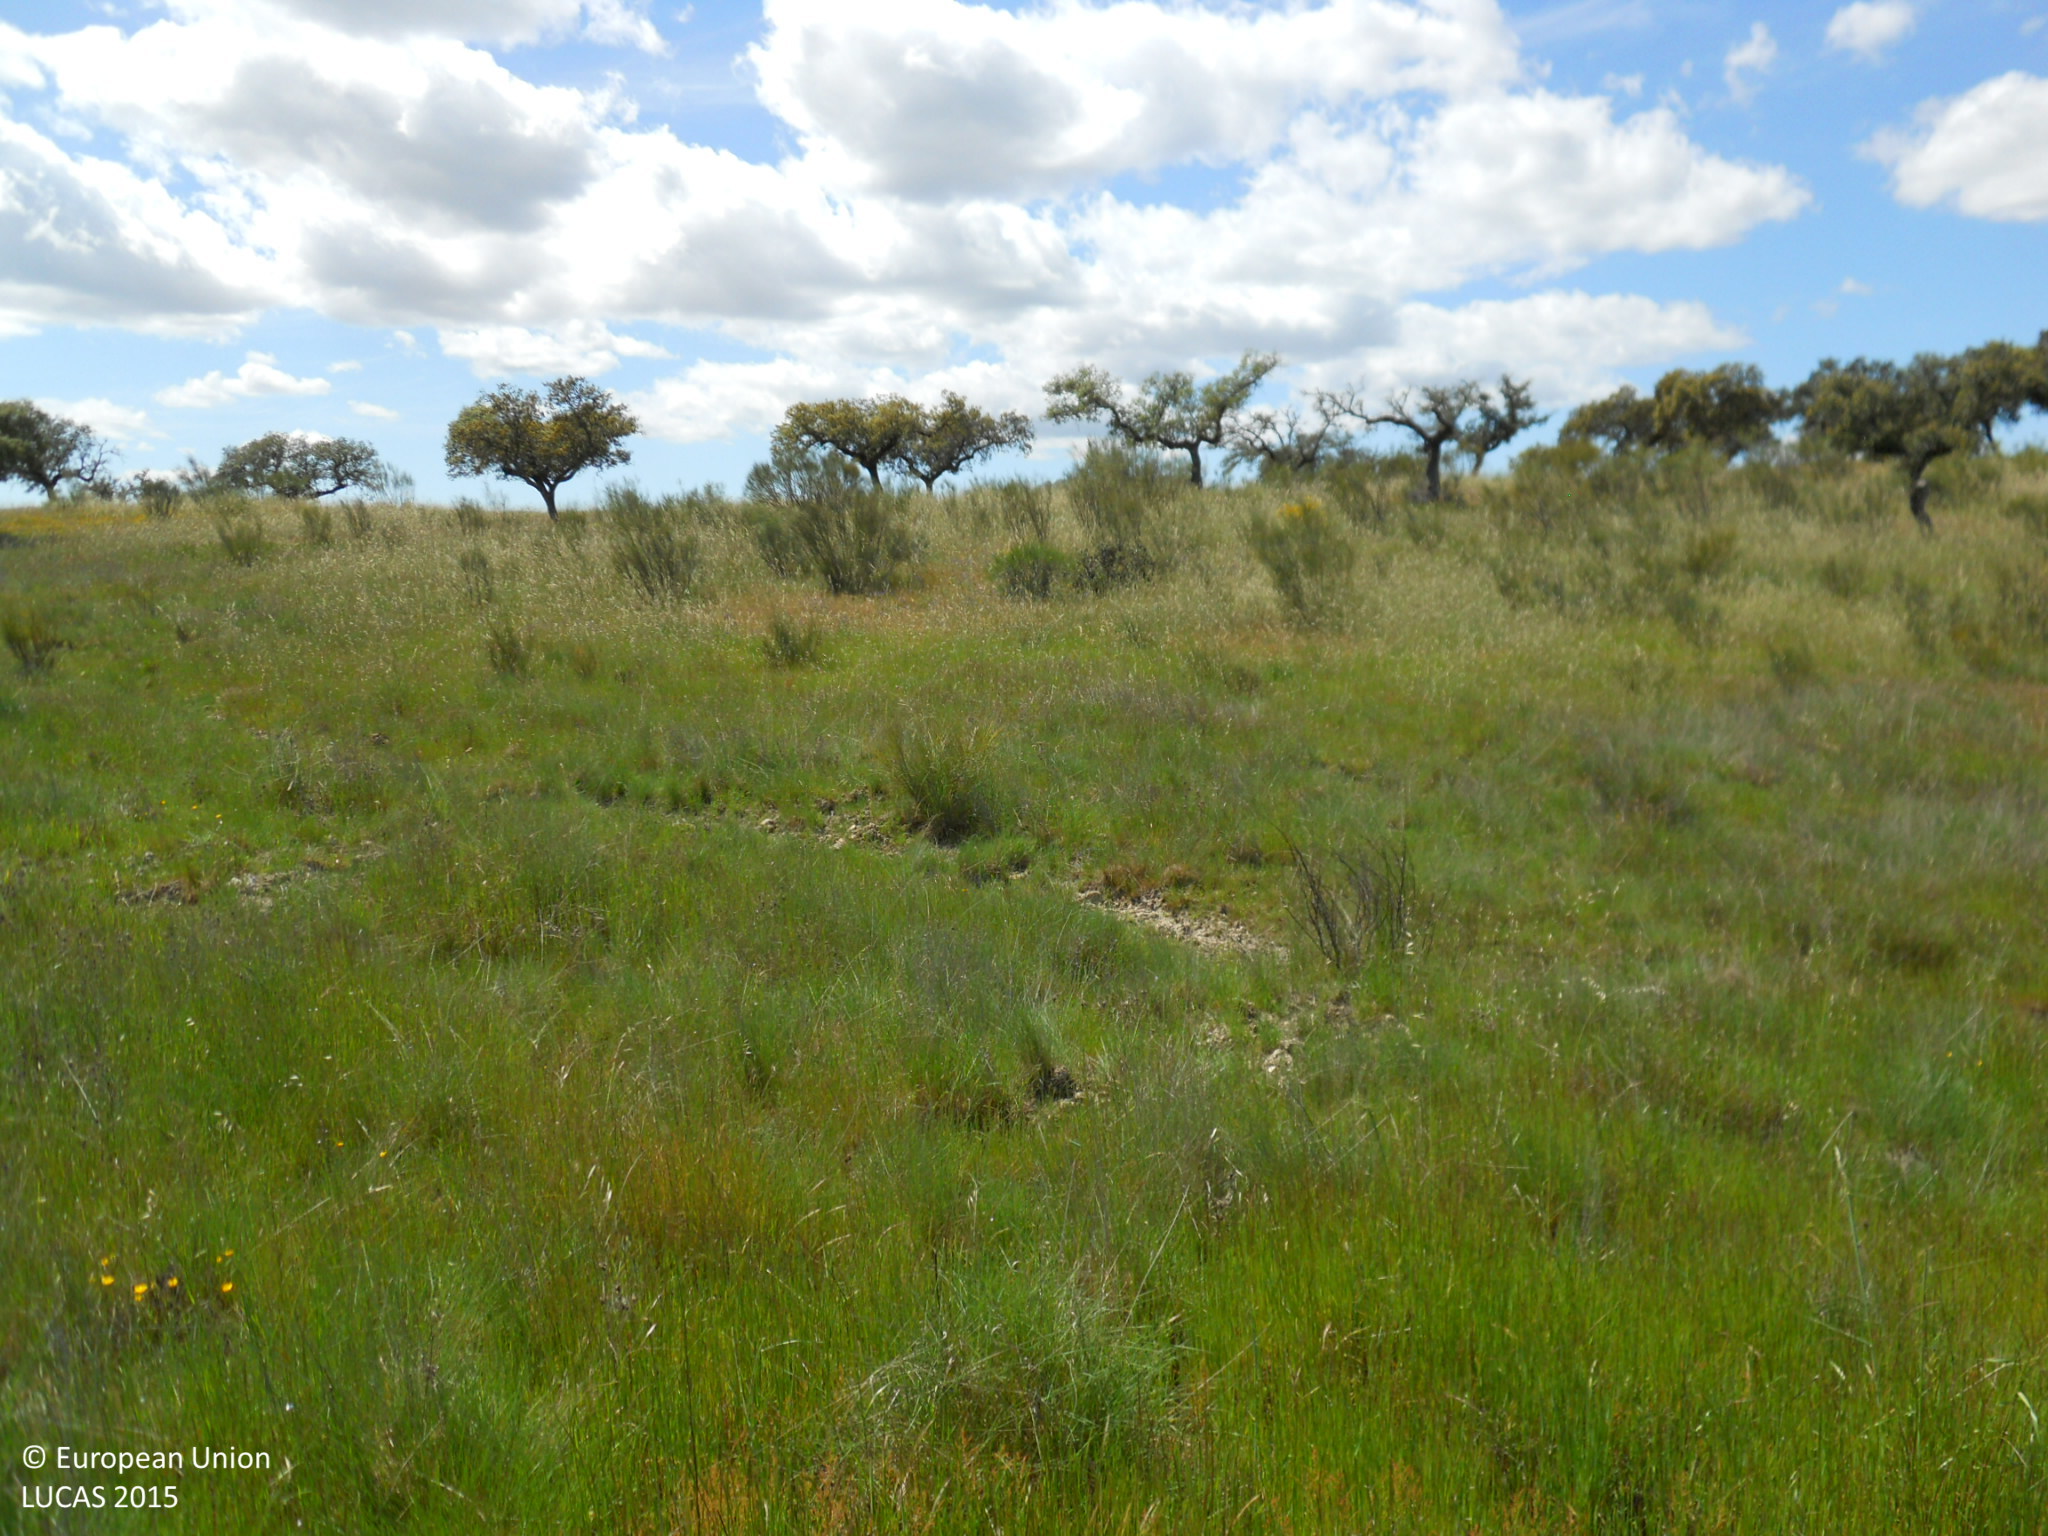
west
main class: Grassland
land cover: Grassland without tree/shrub cover
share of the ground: > 75 %
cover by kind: herbaceous plants 95 %, shrubs 5 %
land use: Agriculture (excluding fallow land and kitchen gardens)
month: April
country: ES
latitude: 39.2688
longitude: -7.1066
